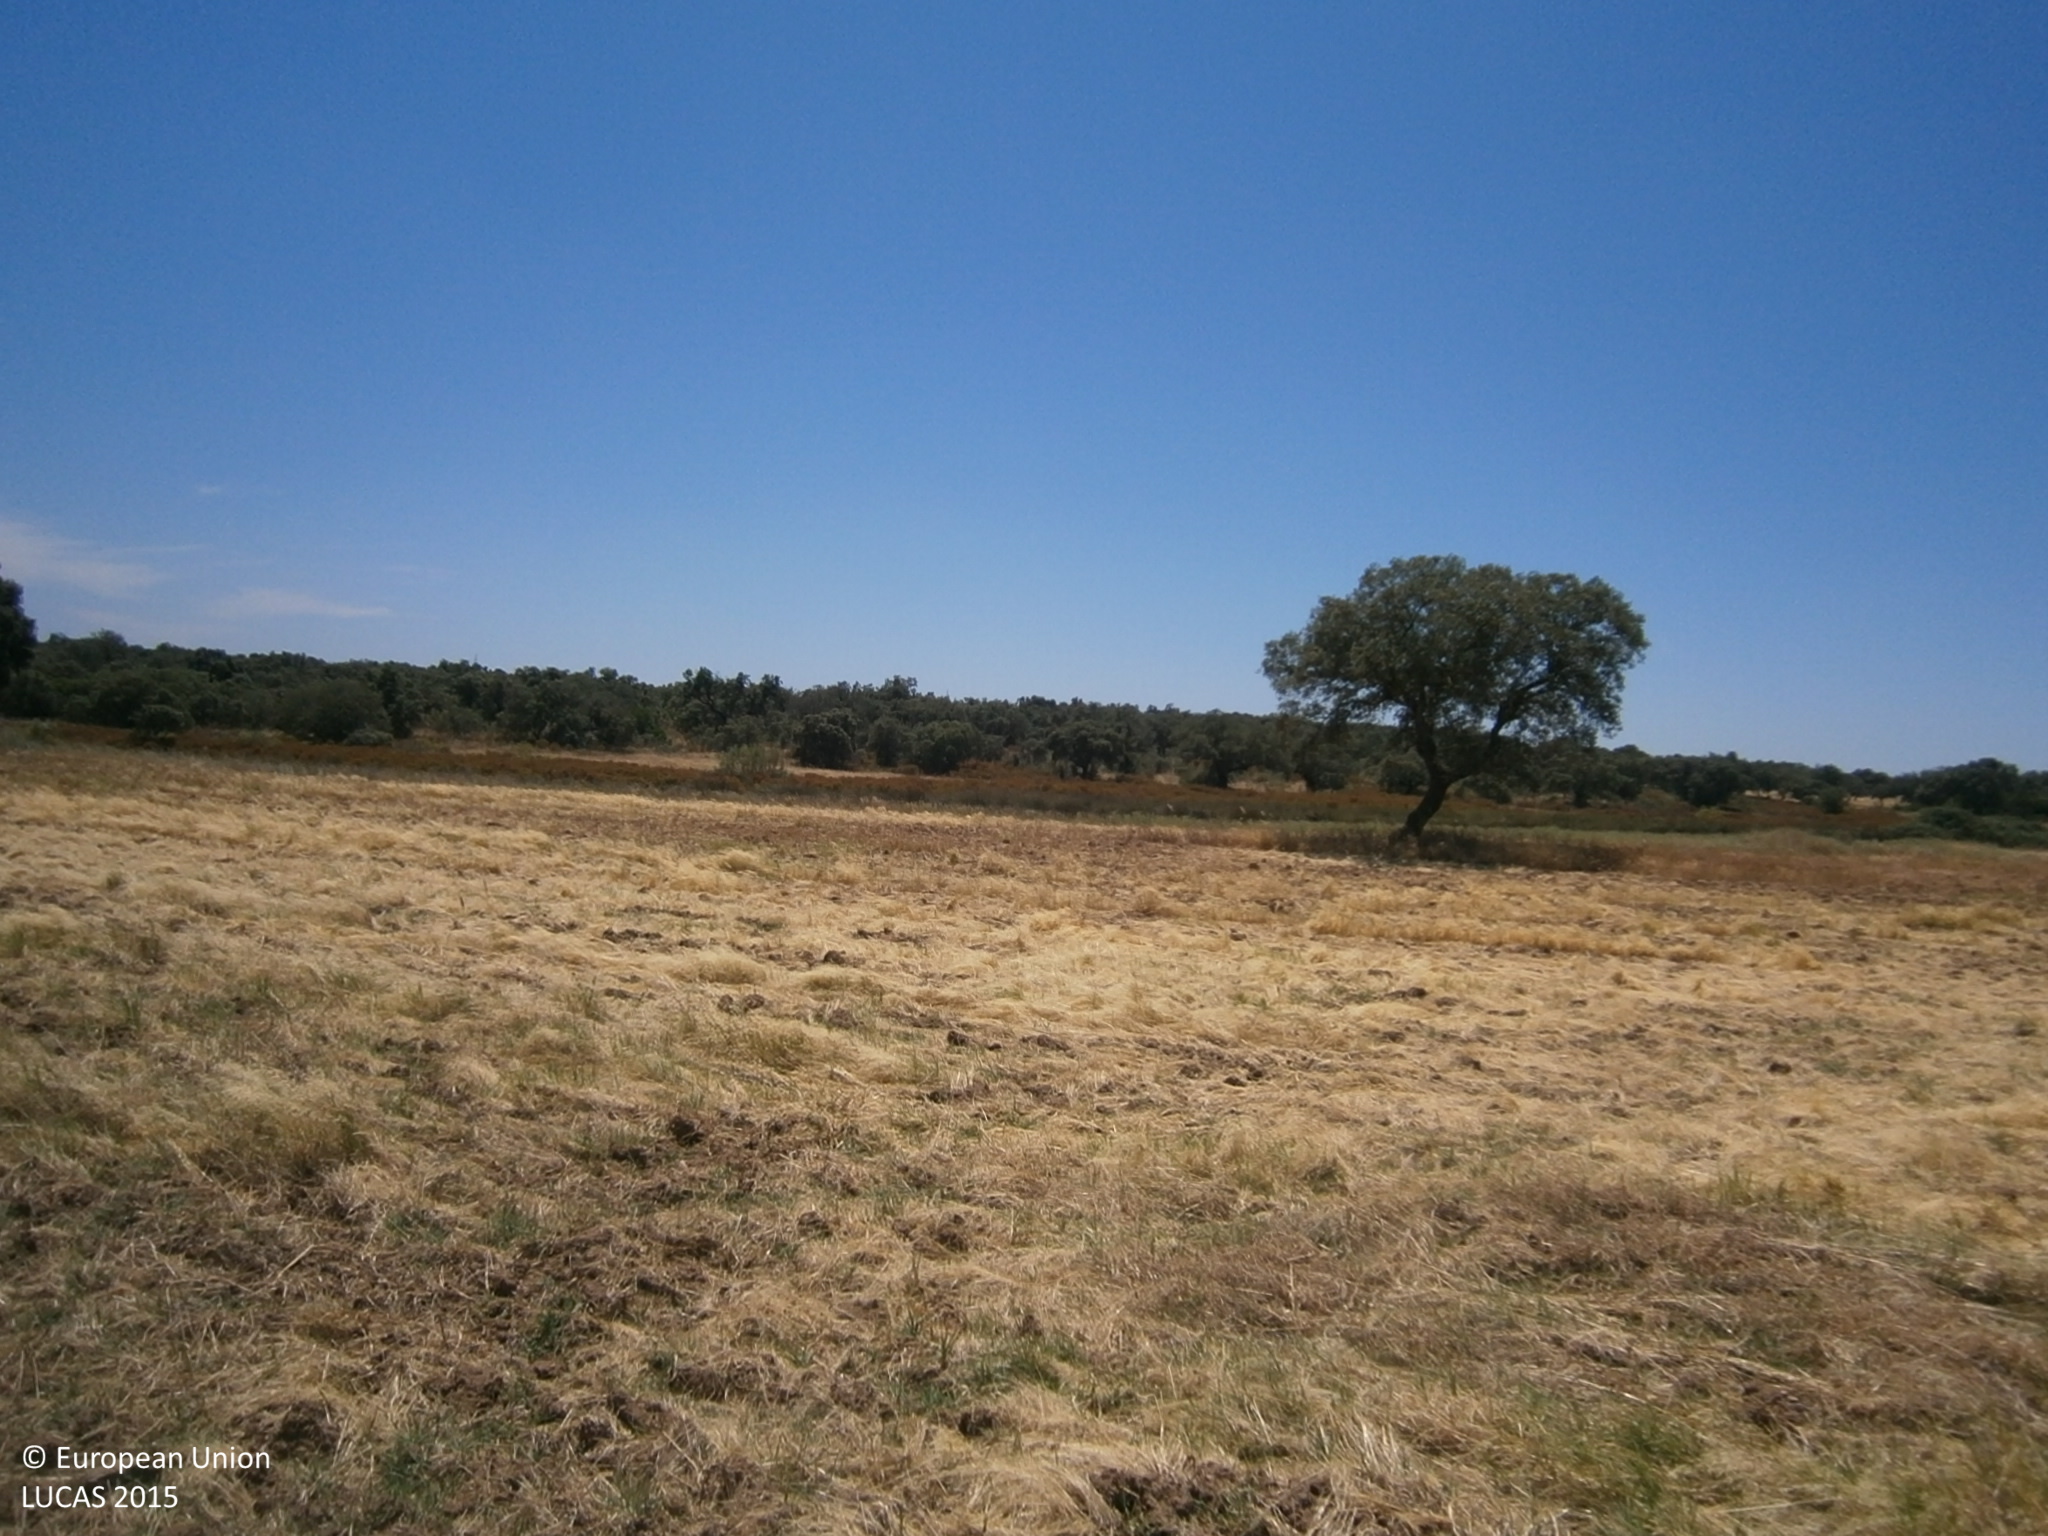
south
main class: Grassland
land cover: Spontaneously vegetated surfaces
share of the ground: > 75 %
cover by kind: herbaceous plants 90 %, unconsolidated bare surface 10 %
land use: Fallow land
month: June
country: ES
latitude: 38.6425
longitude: -6.8954
